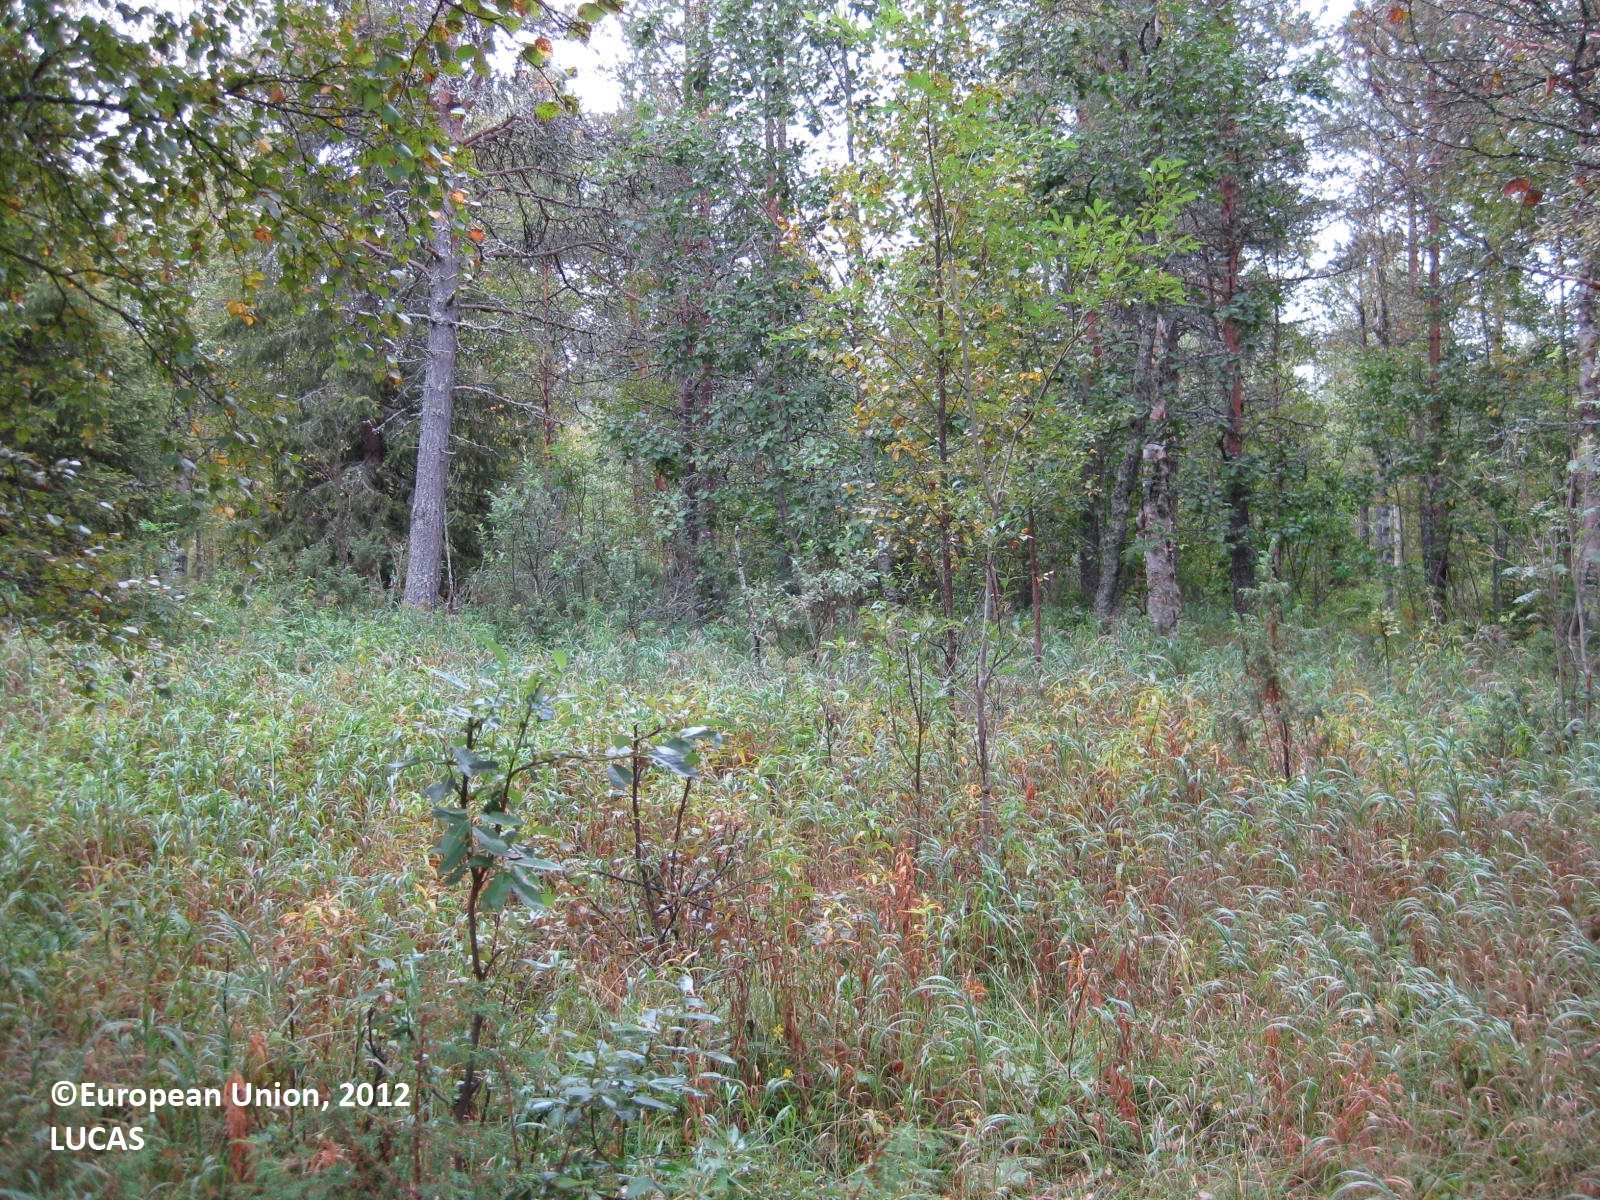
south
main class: Woodland
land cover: Pine dominated mixed woodland
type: boreal forest
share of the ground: 50 - 75 %
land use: Forestry
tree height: > 5 m
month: August
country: FI
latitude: 66.0889
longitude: 28.7560
